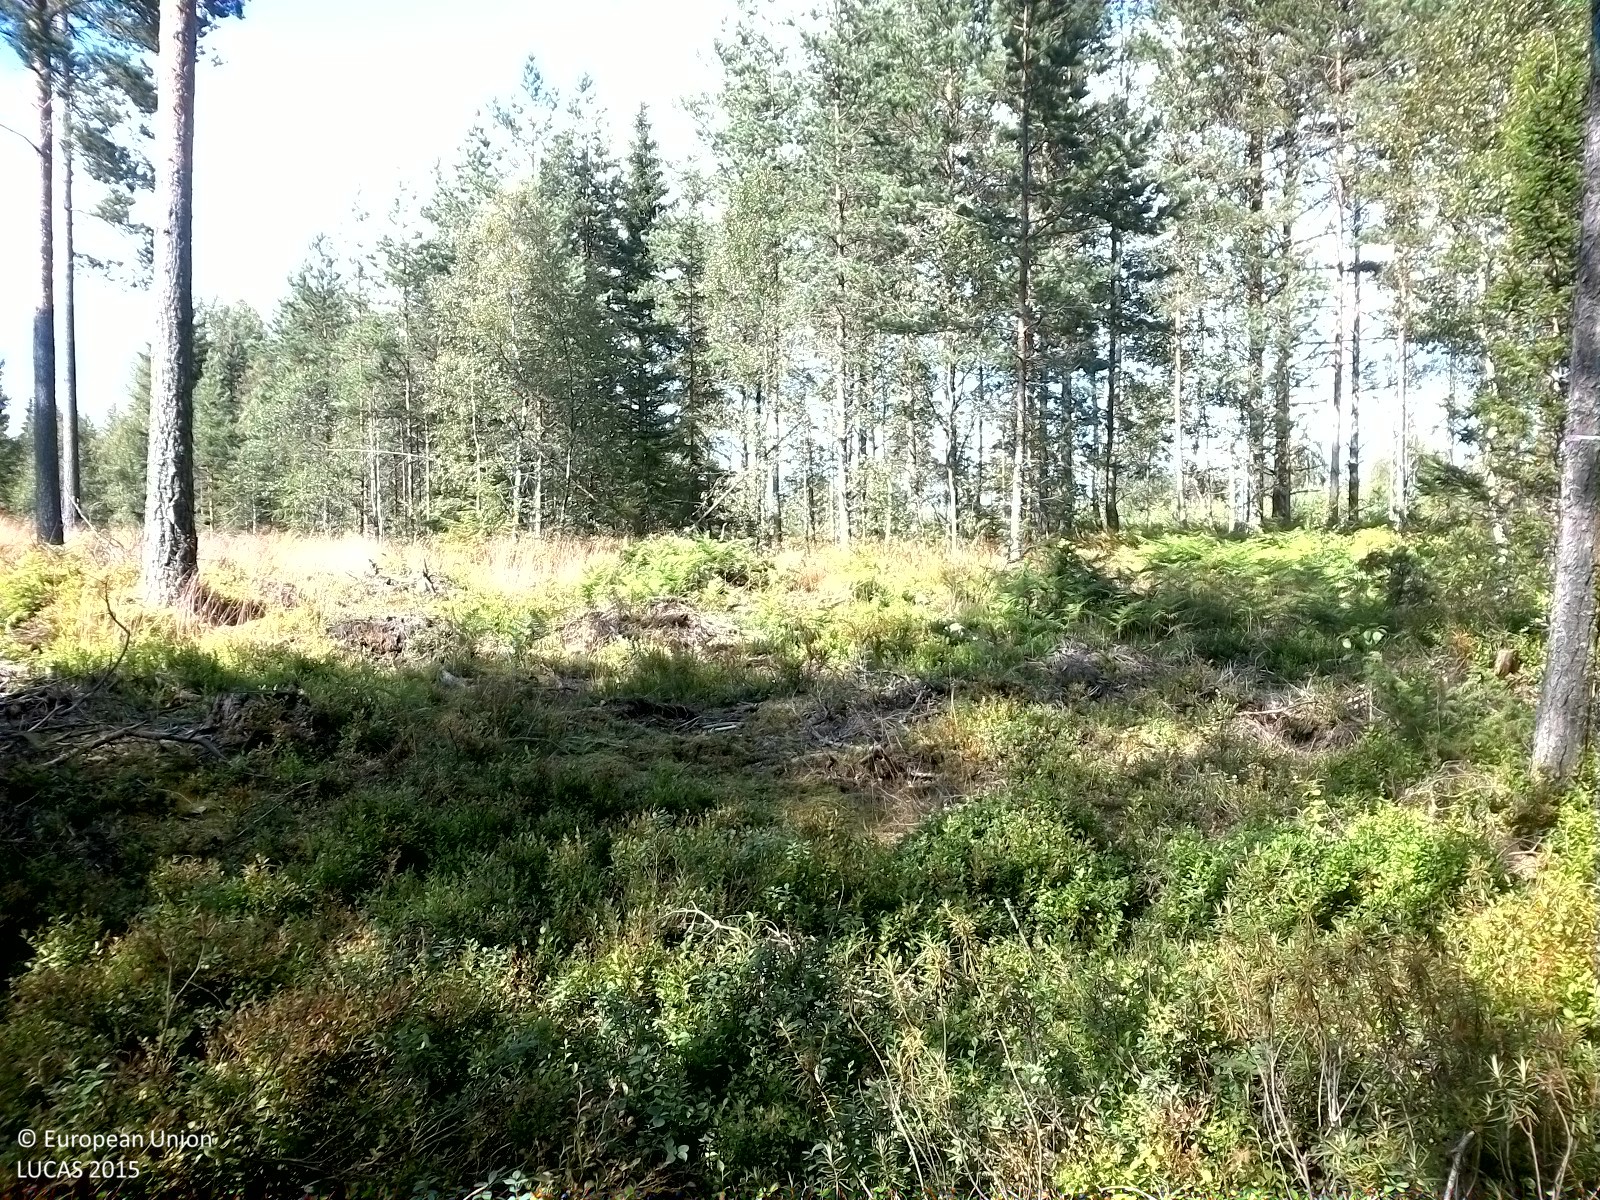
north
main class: Woodland
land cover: Pine dominated mixed woodland
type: boreal forest
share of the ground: 25 - 50 %
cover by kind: herbaceous plants 45 %, coniferous forest trees 20 %, shrubs 15 %, broadleaved forest trees 10 %, lichens and mosses 10 %
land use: Forestry
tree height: > 5 m
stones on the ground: < 10 %
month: August
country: SE
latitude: 58.9527
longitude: 15.0859
